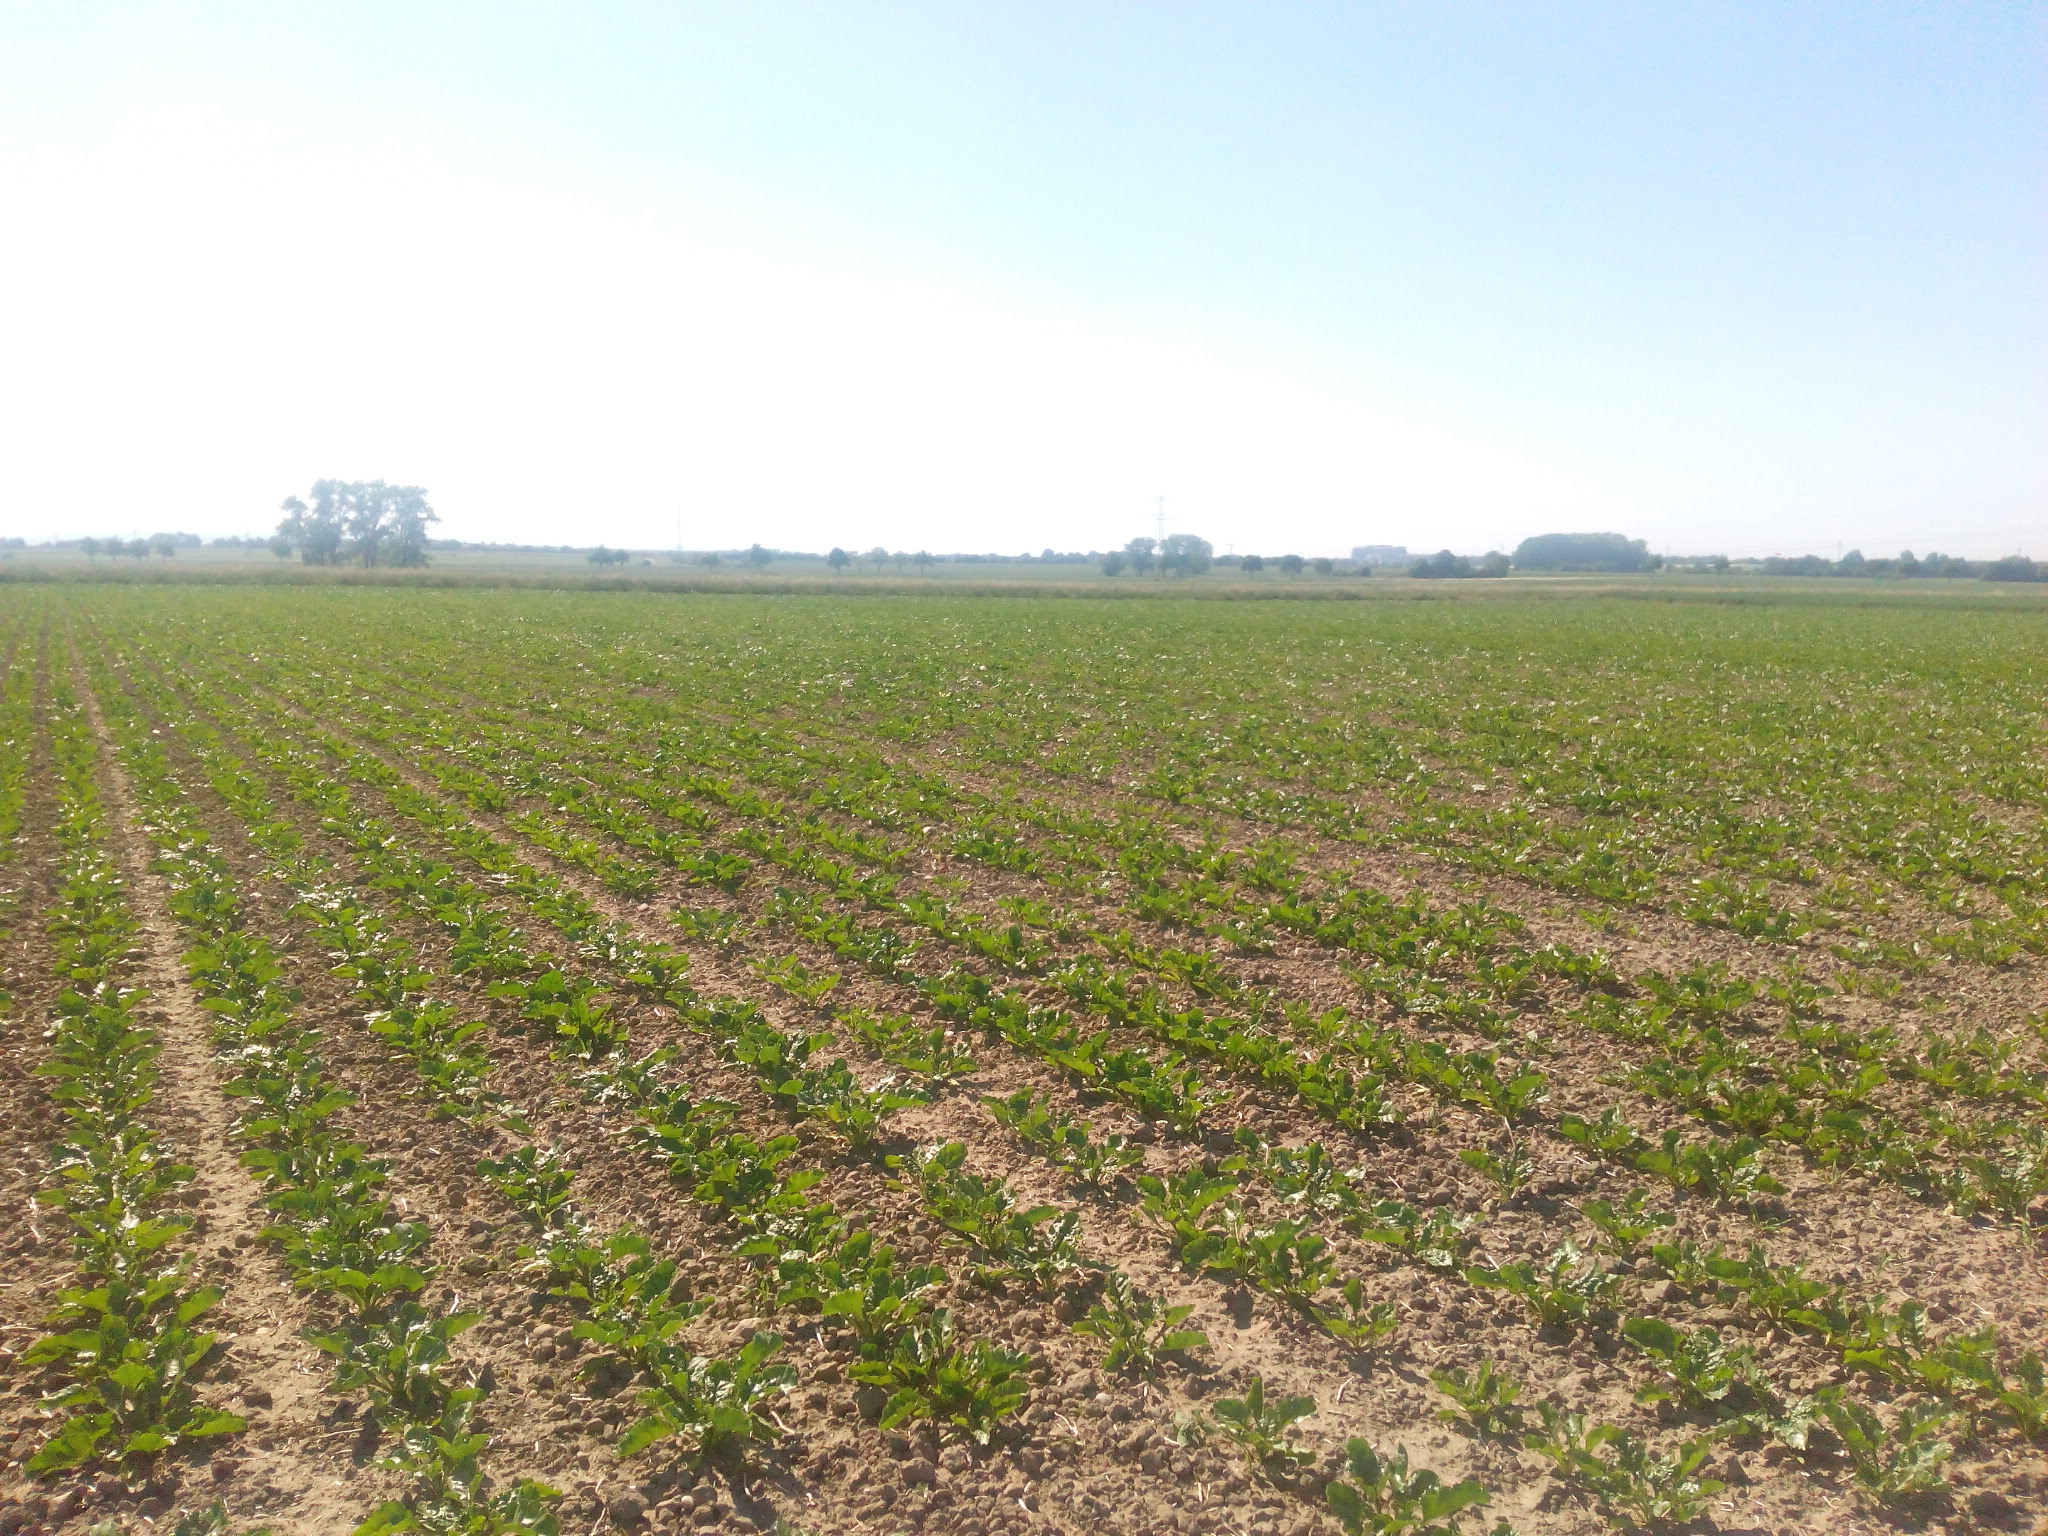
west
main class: Cropland
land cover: Sugar beet
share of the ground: 25 - 50 %
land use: Agriculture (excluding fallow land and kitchen gardens)
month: June
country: DE
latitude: 52.2875
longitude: 9.8681
